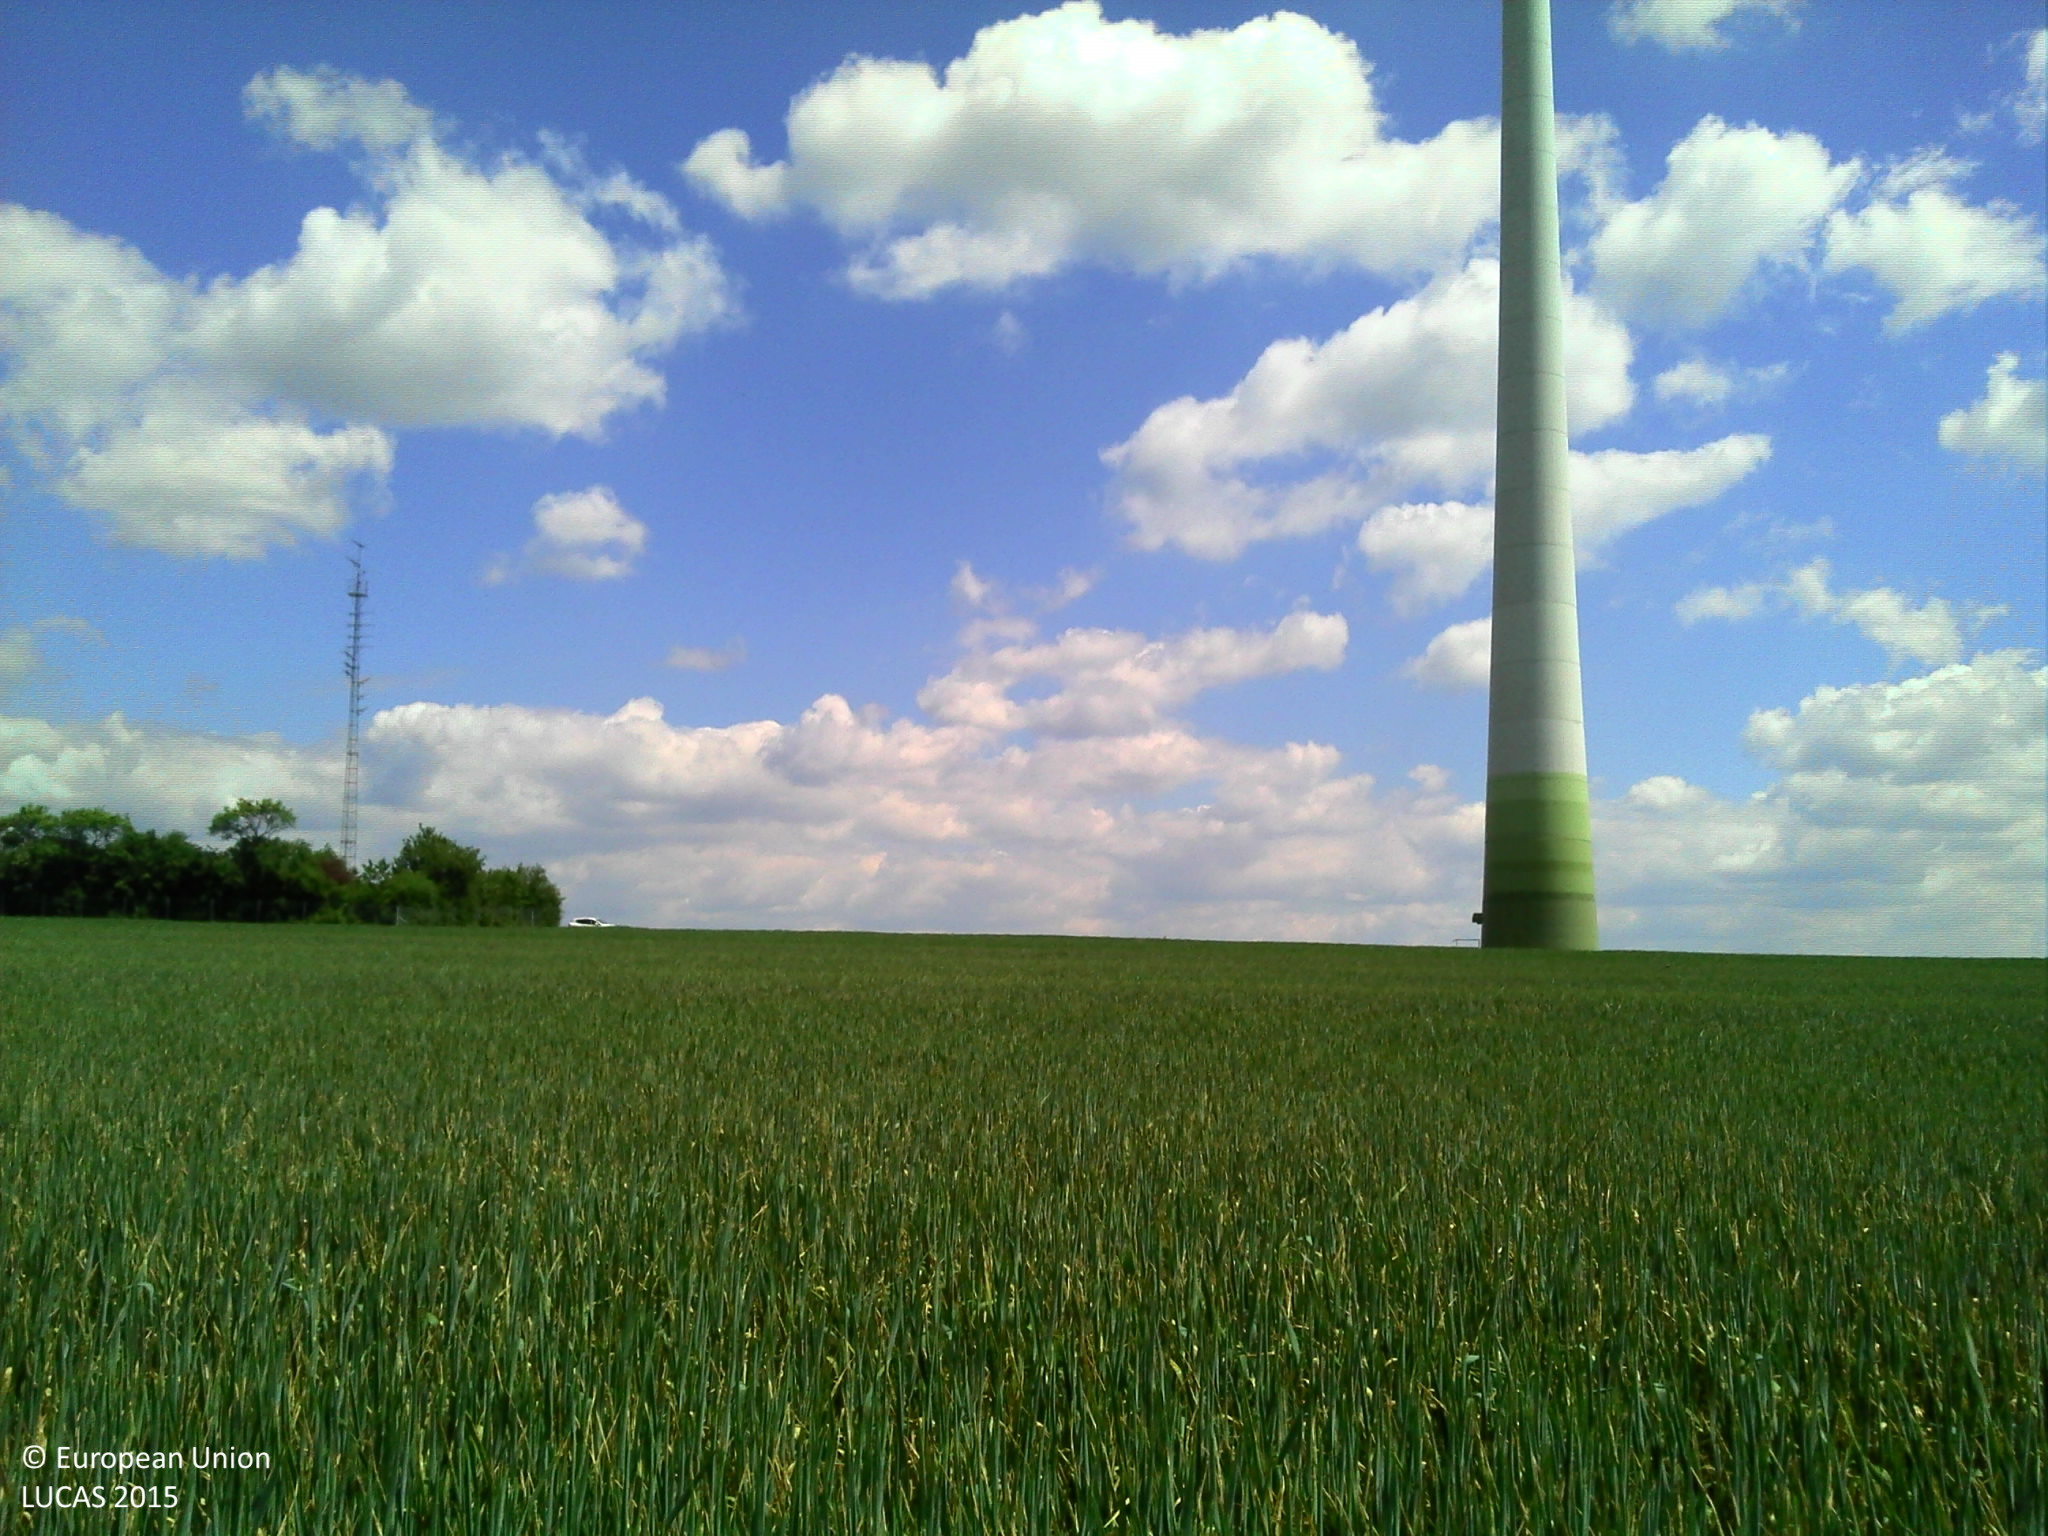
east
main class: Cropland
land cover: Common wheat
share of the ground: > 75 %
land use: Agriculture (excluding fallow land and kitchen gardens)
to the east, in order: Common wheat; Tracks; Common wheat; Paved roads, cycling and walking lanes; Common wheat; Tracks; Maize
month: May
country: LU
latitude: 49.7522
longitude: 6.4882
